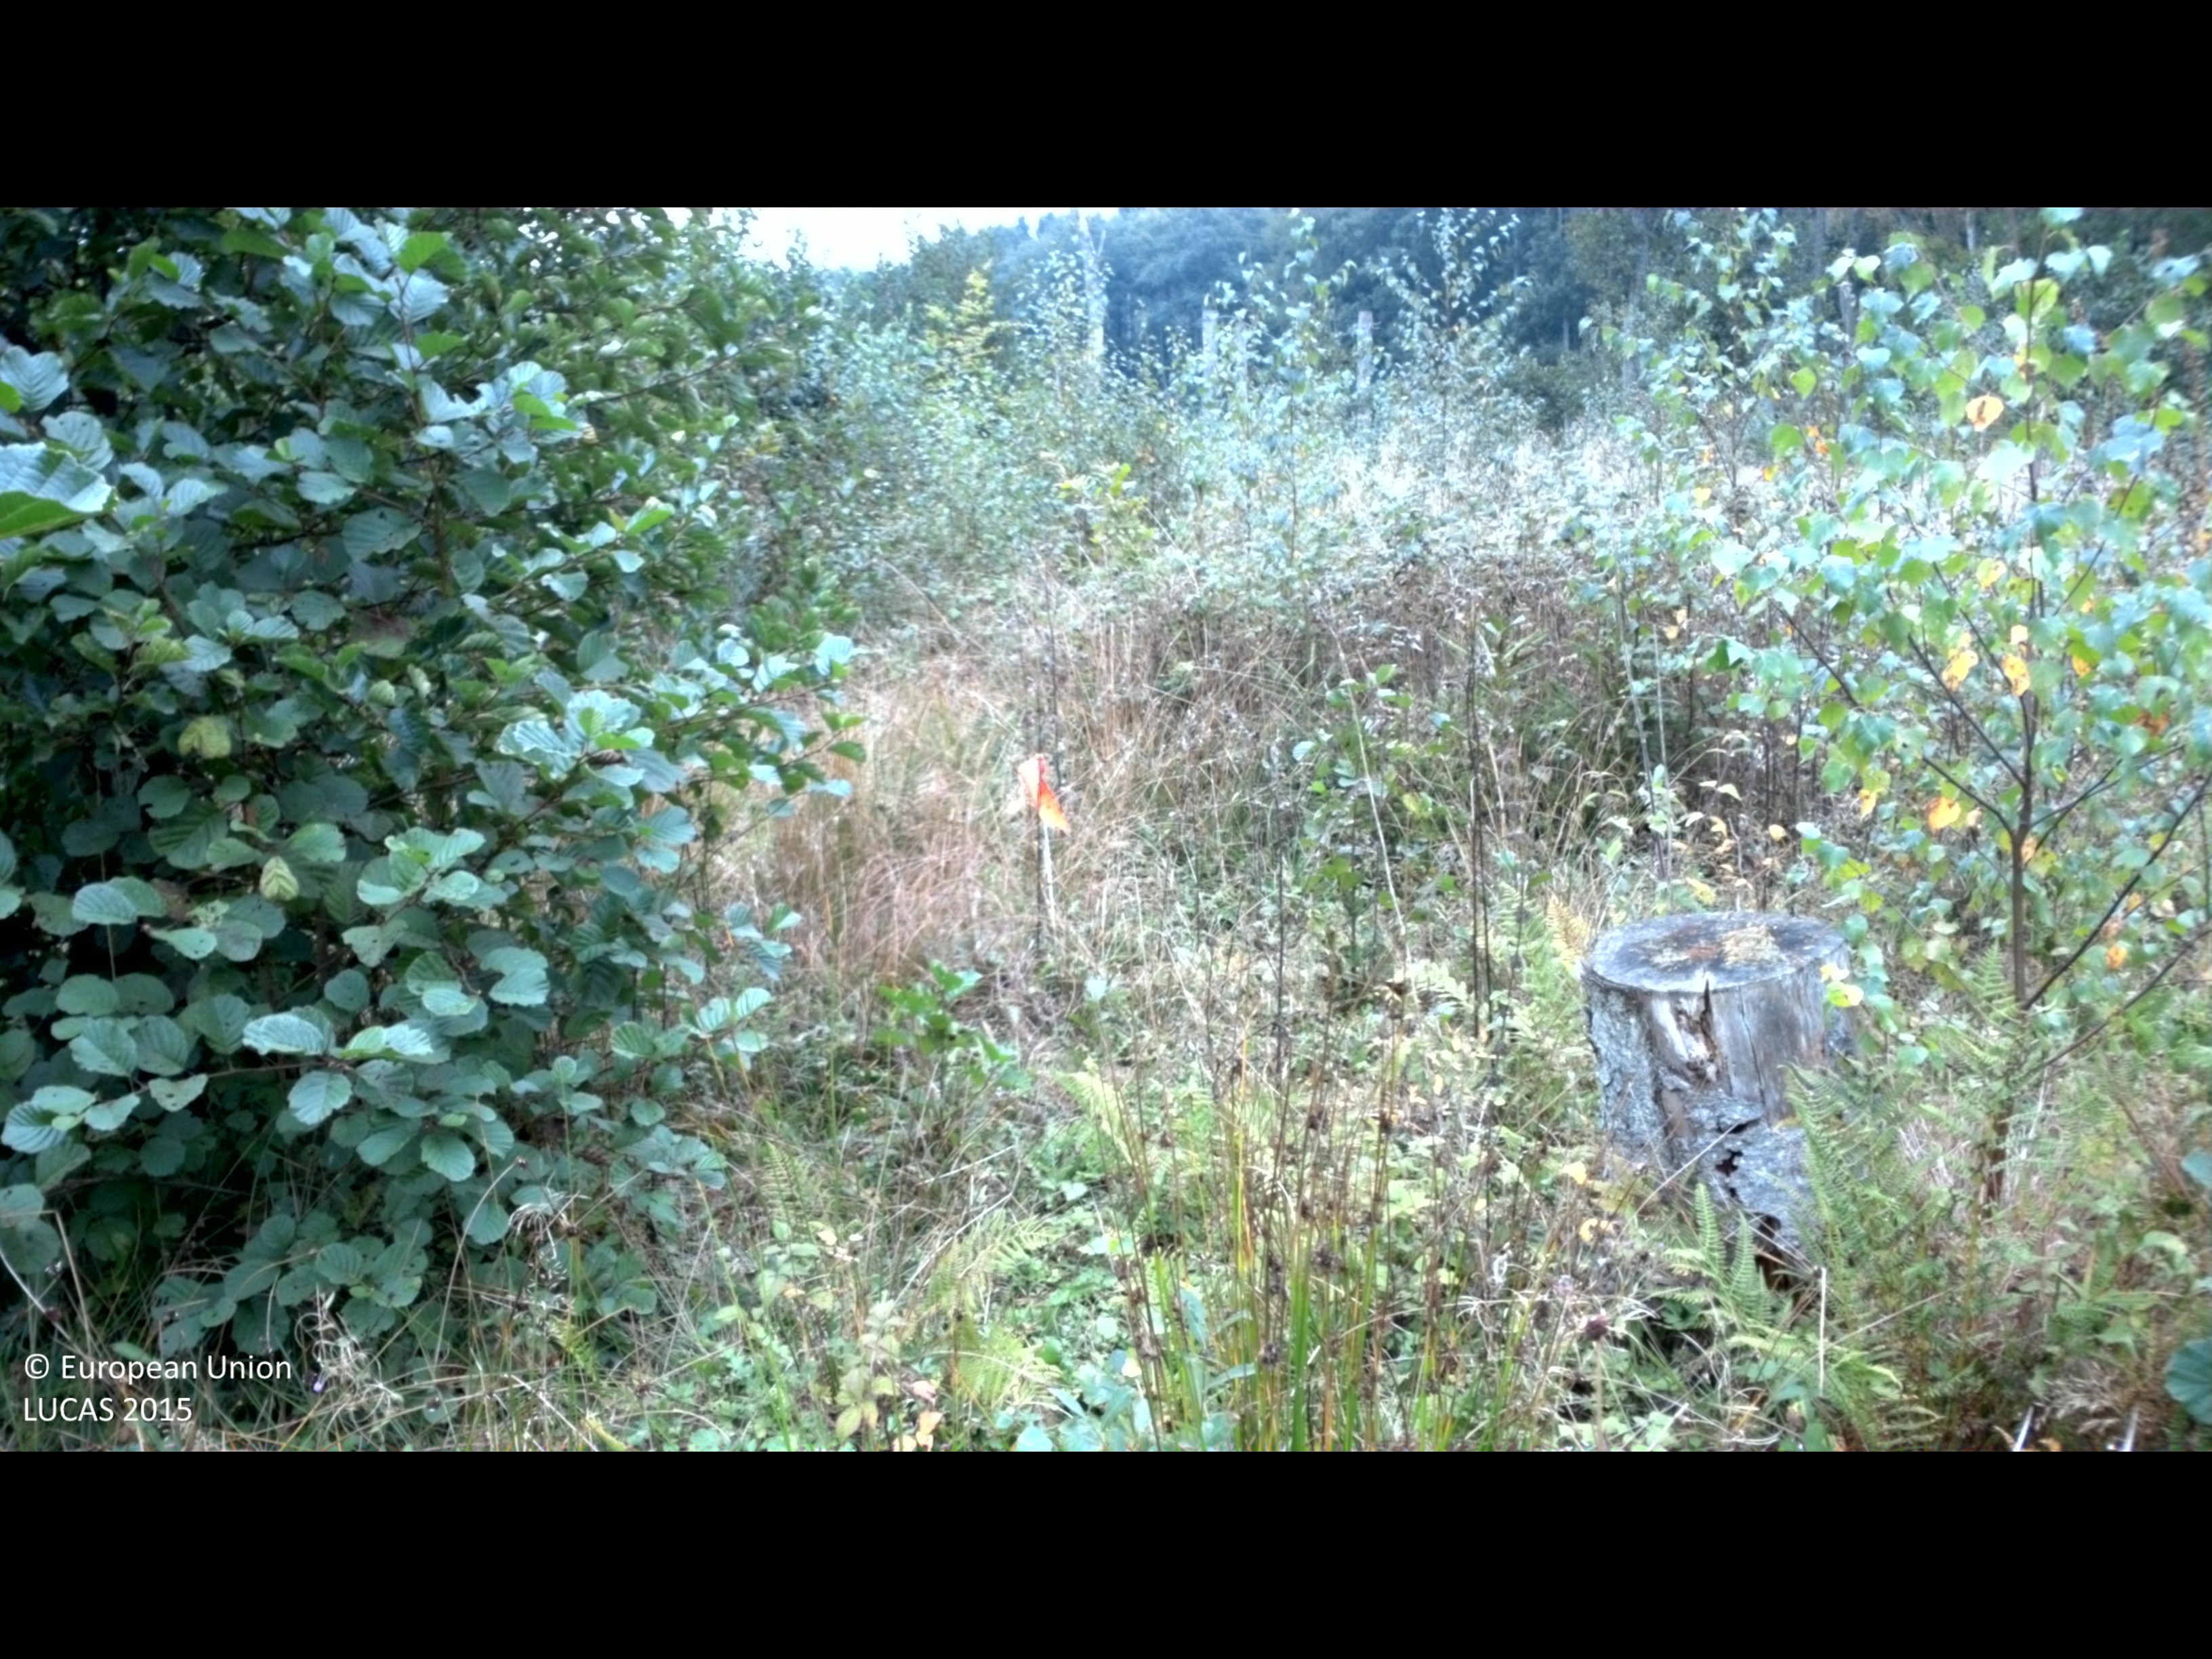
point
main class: Woodland
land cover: Broadleaved woodland
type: hemiboreal forest and nemoral coniferous forest and mixed broadleaved-coniferous forest
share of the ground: 25 - 50 %
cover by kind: broadleaved forest trees 50 %, herbaceous plants 30 %, shrubs 20 %
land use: Forestry
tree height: < 5 m
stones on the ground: < 10 %
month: September
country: SE
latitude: 56.0167
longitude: 14.0243
